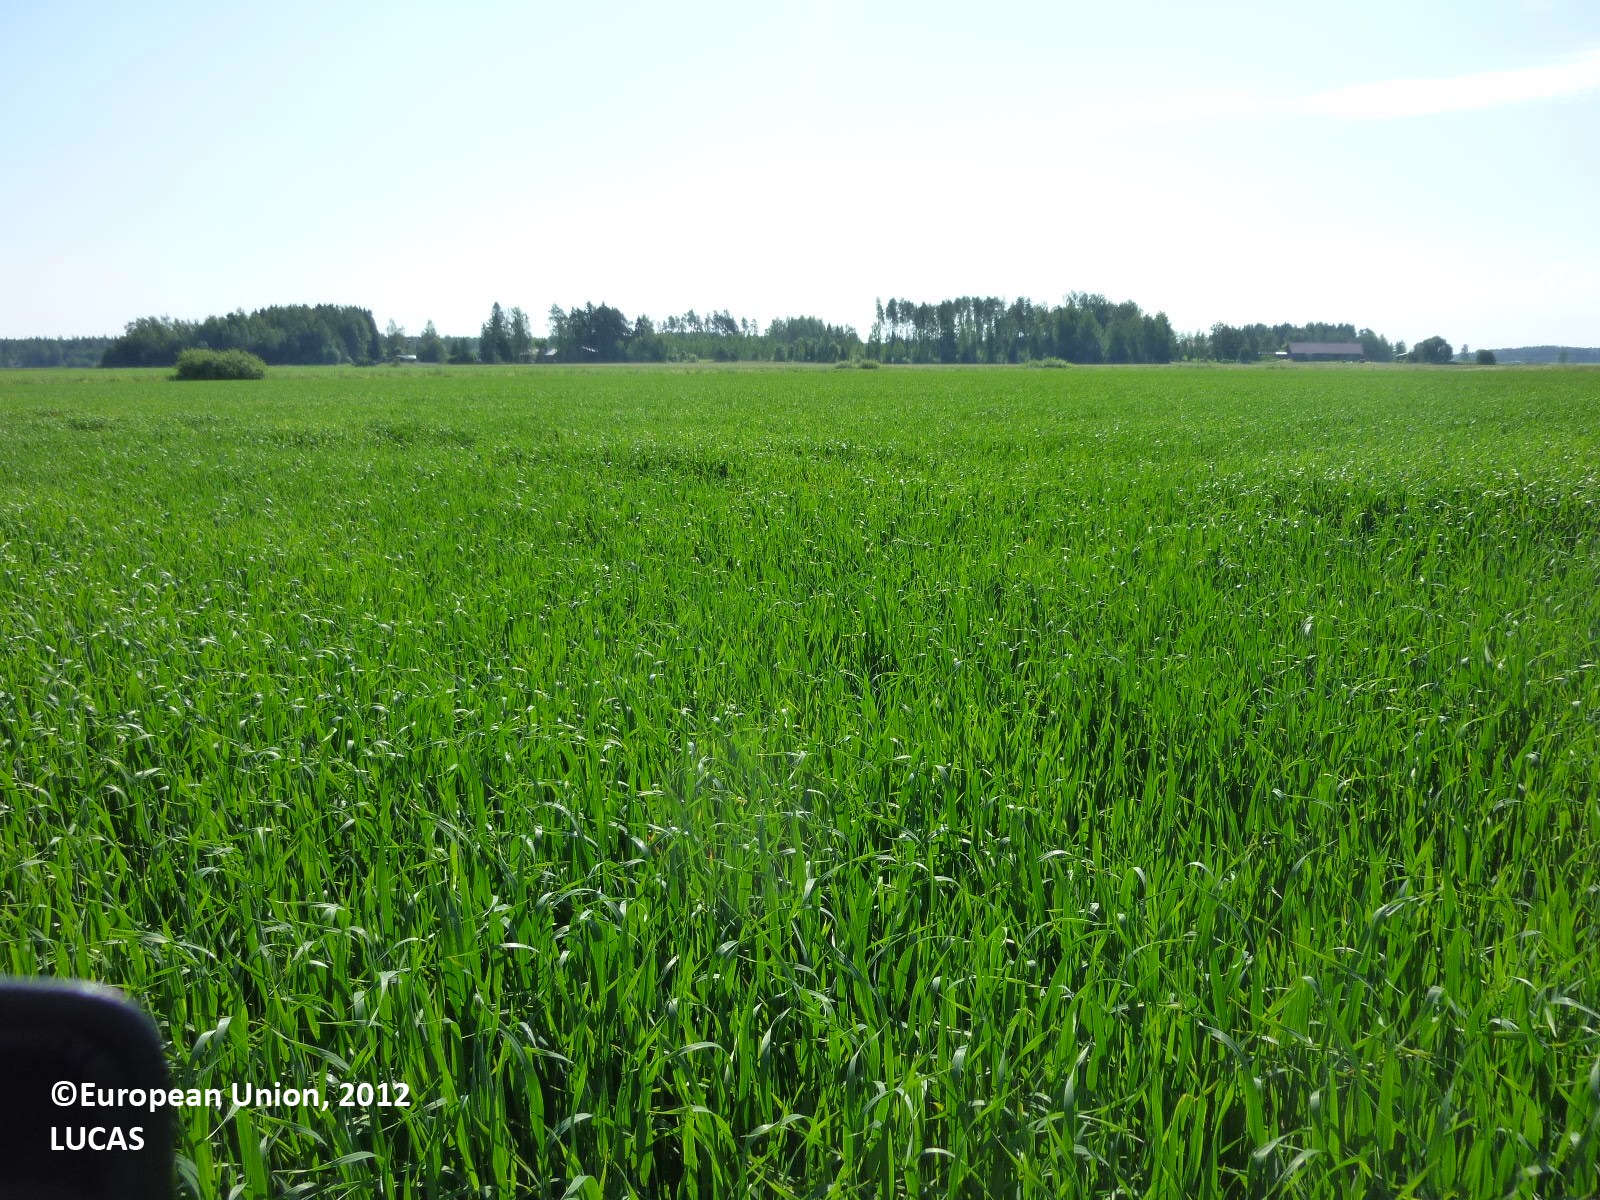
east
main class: Cropland
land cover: Rye
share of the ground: > 75 %
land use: Agriculture (excluding fallow land and kitchen gardens)
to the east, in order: Rye; Grass margins; Ditches and canals; Grass margins; Oats; Grassland with sparse tree/shrub cover; Ditches and canals; Grassland with sparse tree/shrub cover; Temporary grasslands
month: July
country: FI
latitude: 61.2400
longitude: 22.3790
